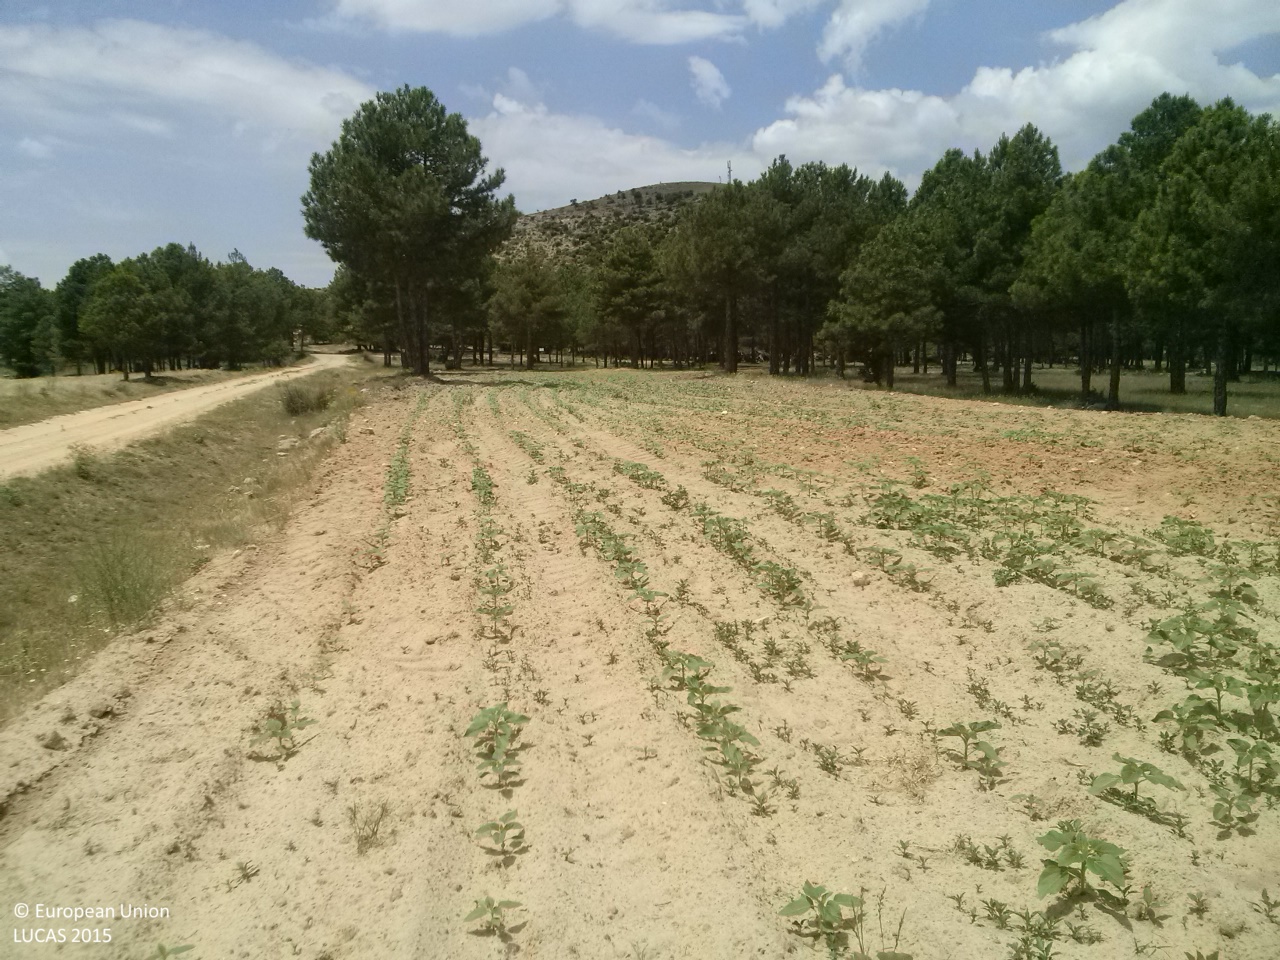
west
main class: Cropland
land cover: Sunflower
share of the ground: < 10 %
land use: Agriculture (excluding fallow land and kitchen gardens)
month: June
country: ES
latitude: 39.9573
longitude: -1.7759
